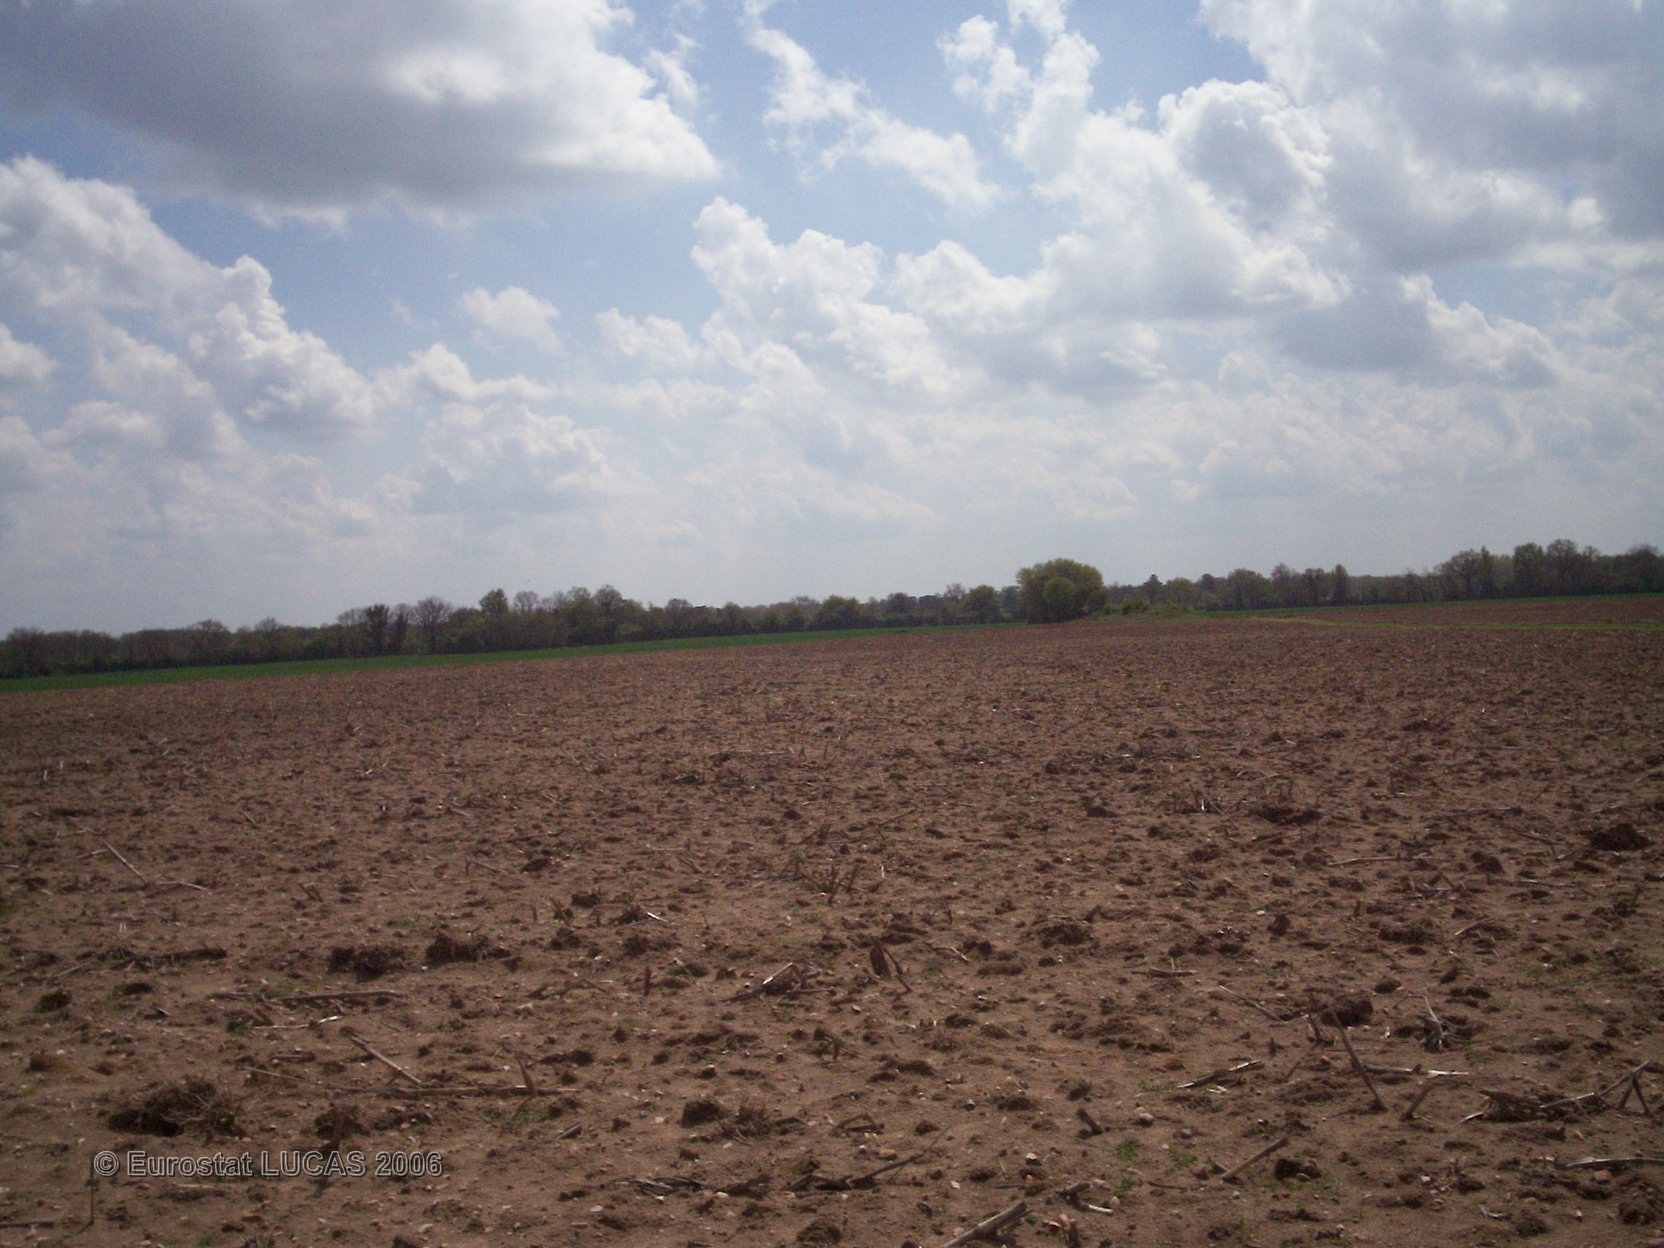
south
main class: Cropland
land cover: Maize
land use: Agriculture (excluding fallow land and kitchen gardens)
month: June
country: FR
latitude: 46.3098
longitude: 0.5174
